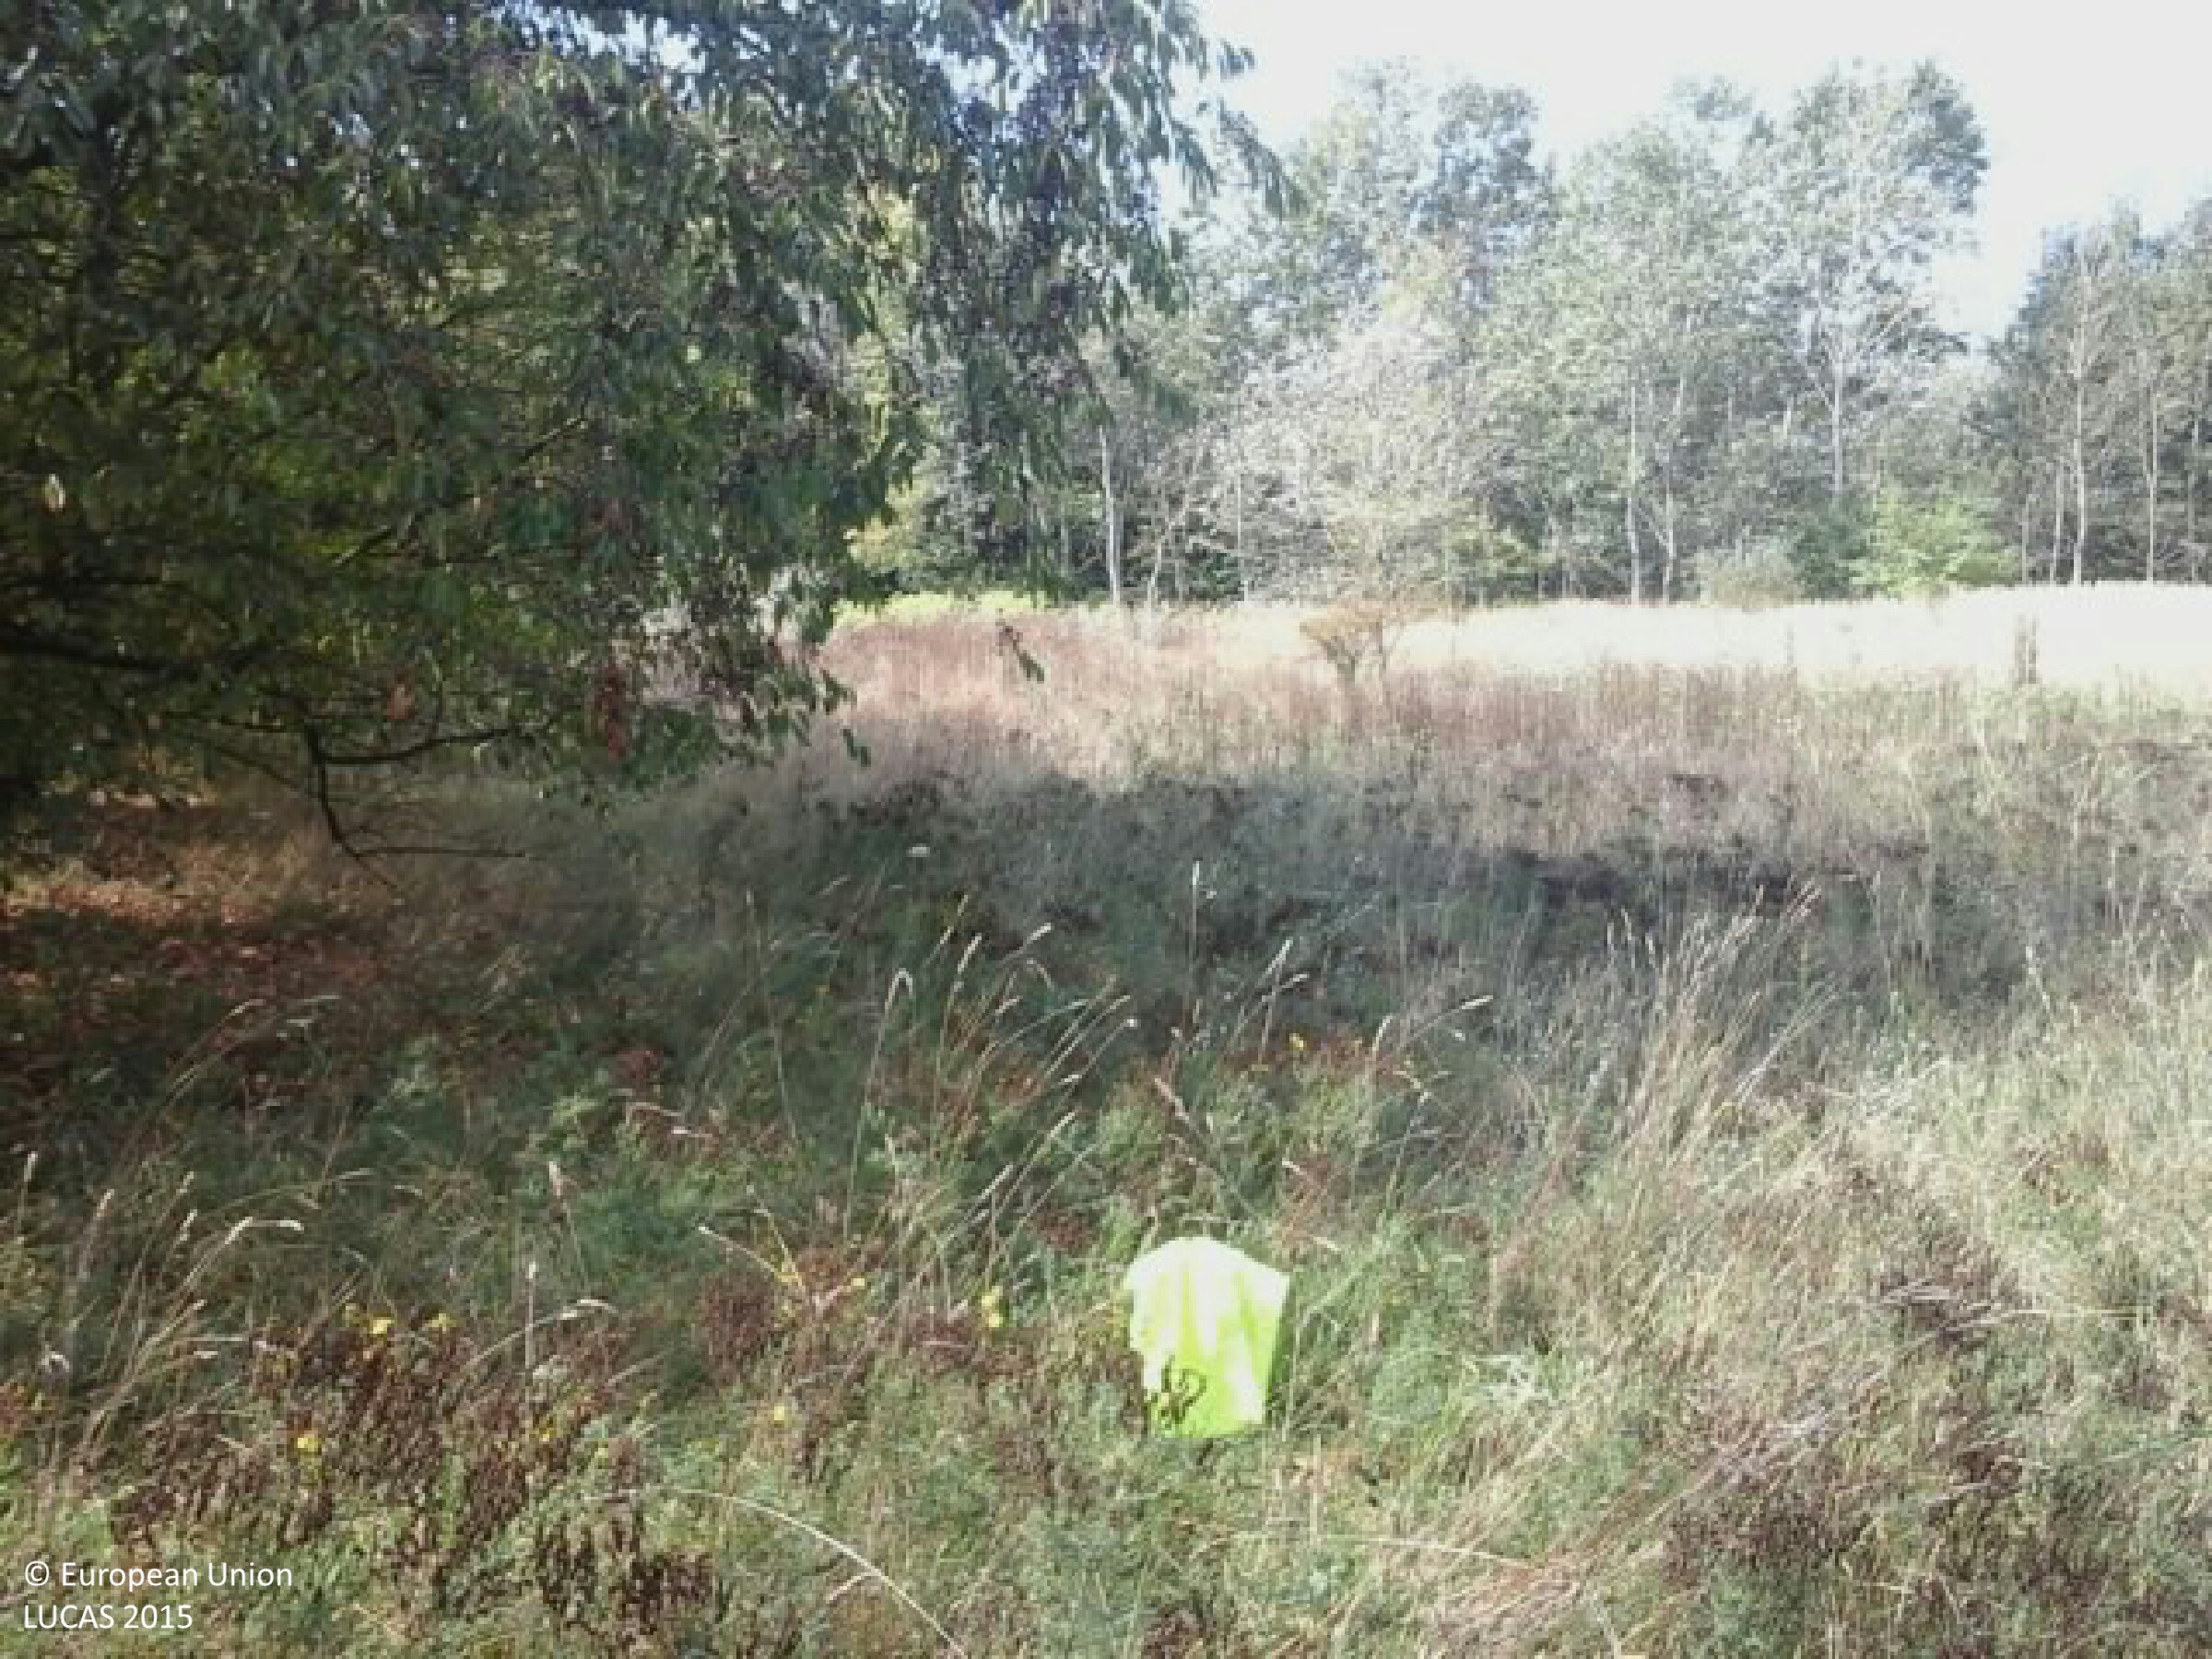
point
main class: Grassland
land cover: Spontaneously vegetated surfaces
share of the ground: > 75 %
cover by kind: herbaceous plants 100 %
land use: Semi-natural and natural areas not in use
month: July
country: HU
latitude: 47.2650
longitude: 19.1237
